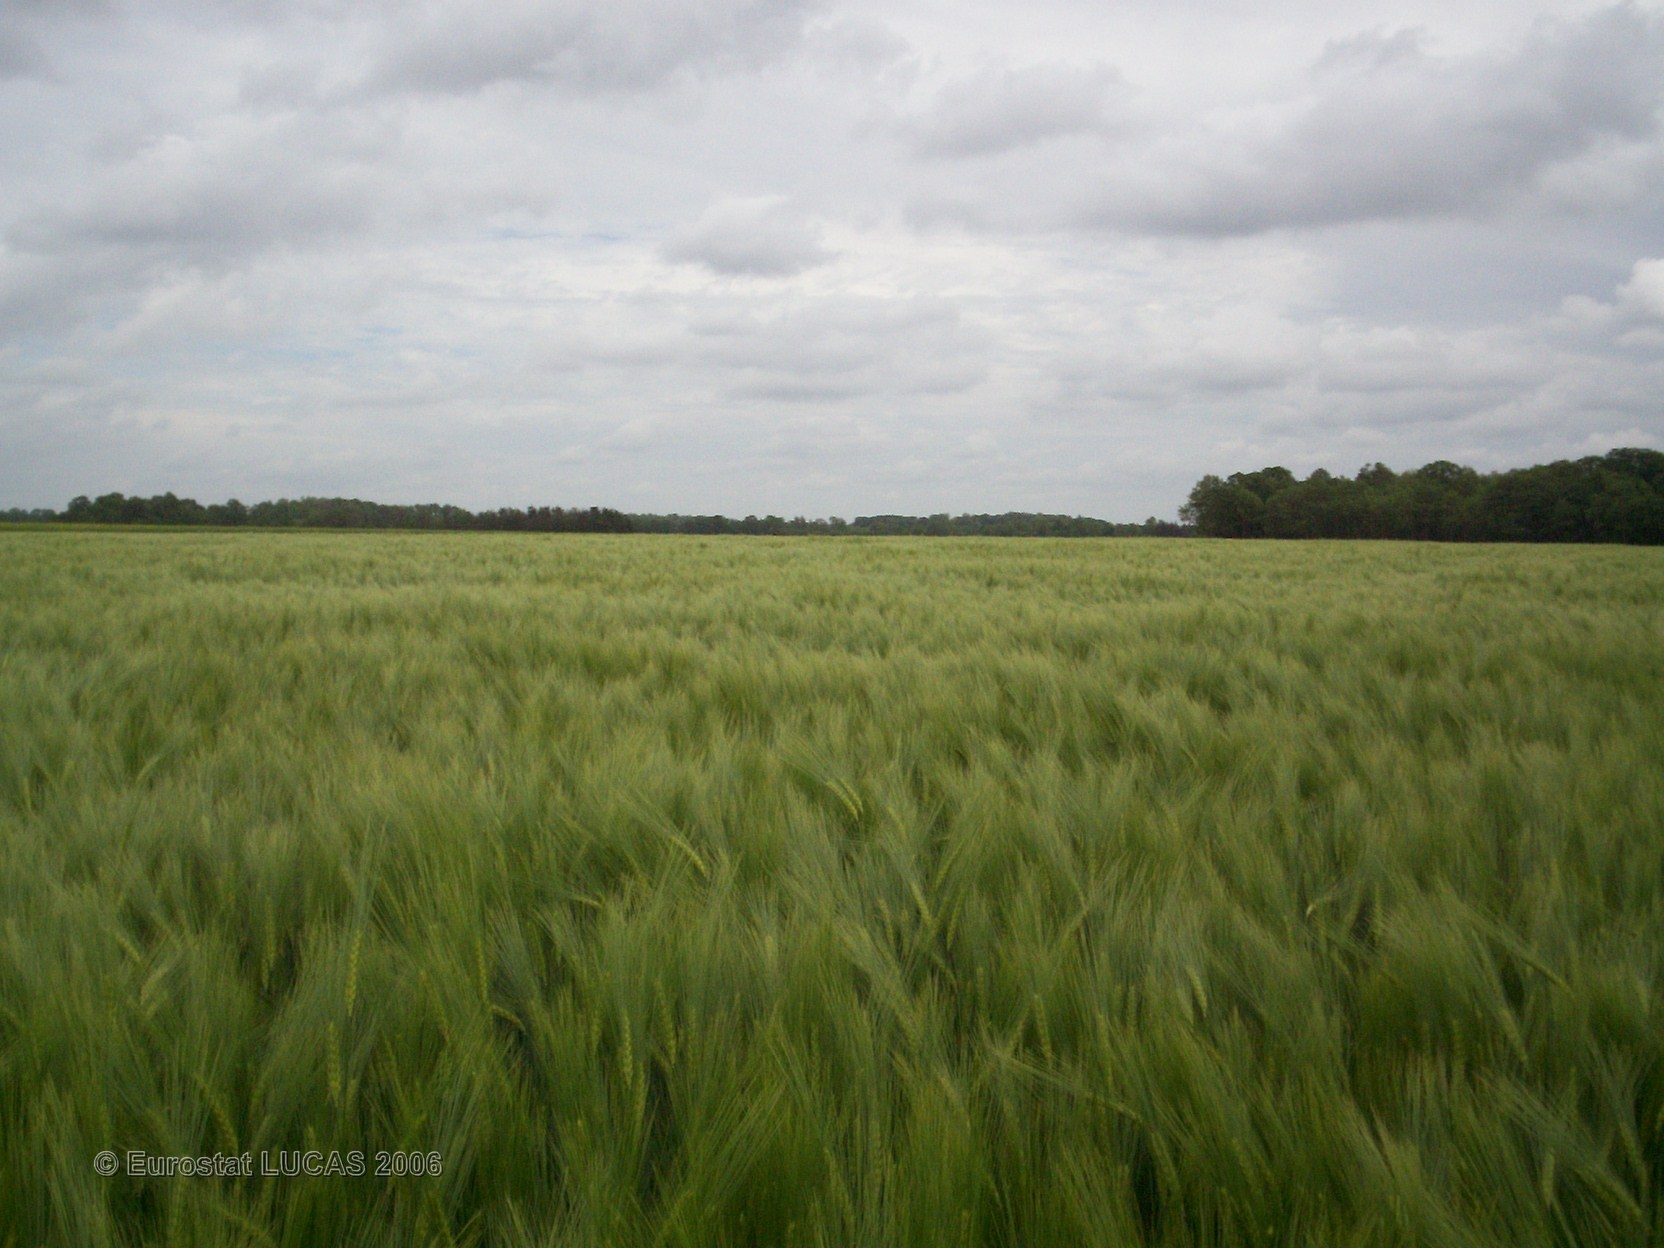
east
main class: Cropland
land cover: Common wheat
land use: Agriculture (excluding fallow land and kitchen gardens)
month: May
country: FR
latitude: 48.6945
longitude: 2.8310
